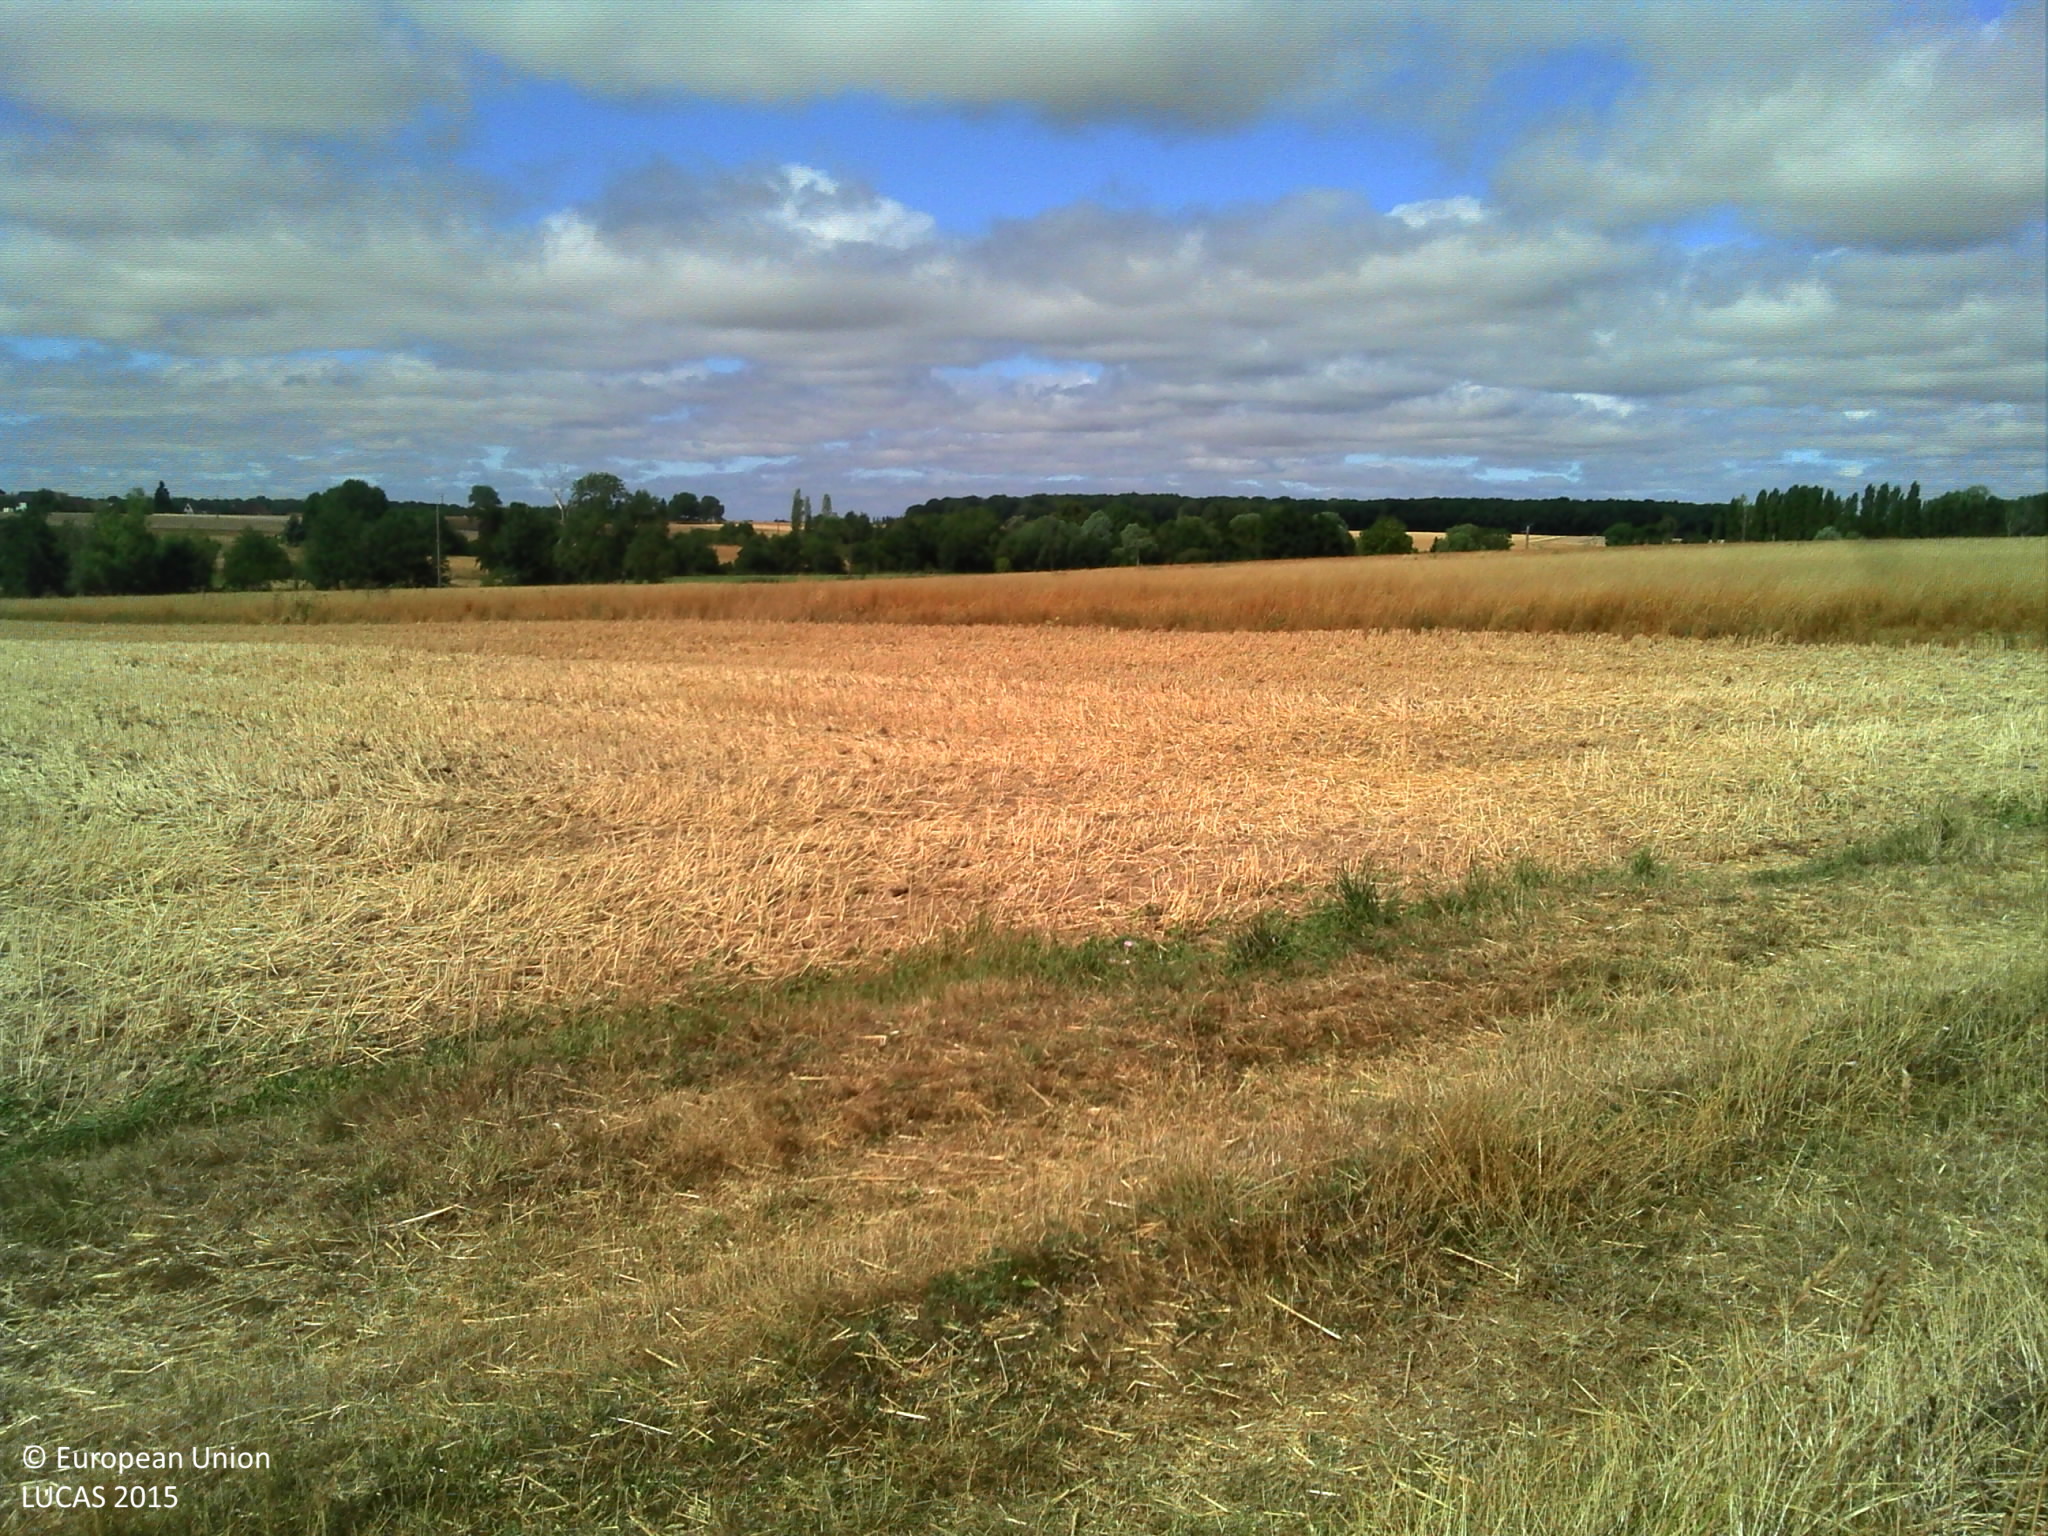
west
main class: Cropland
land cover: Barley
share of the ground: > 75 %
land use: Agriculture (excluding fallow land and kitchen gardens)
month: July
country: FR
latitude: 48.2744
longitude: 1.2643
